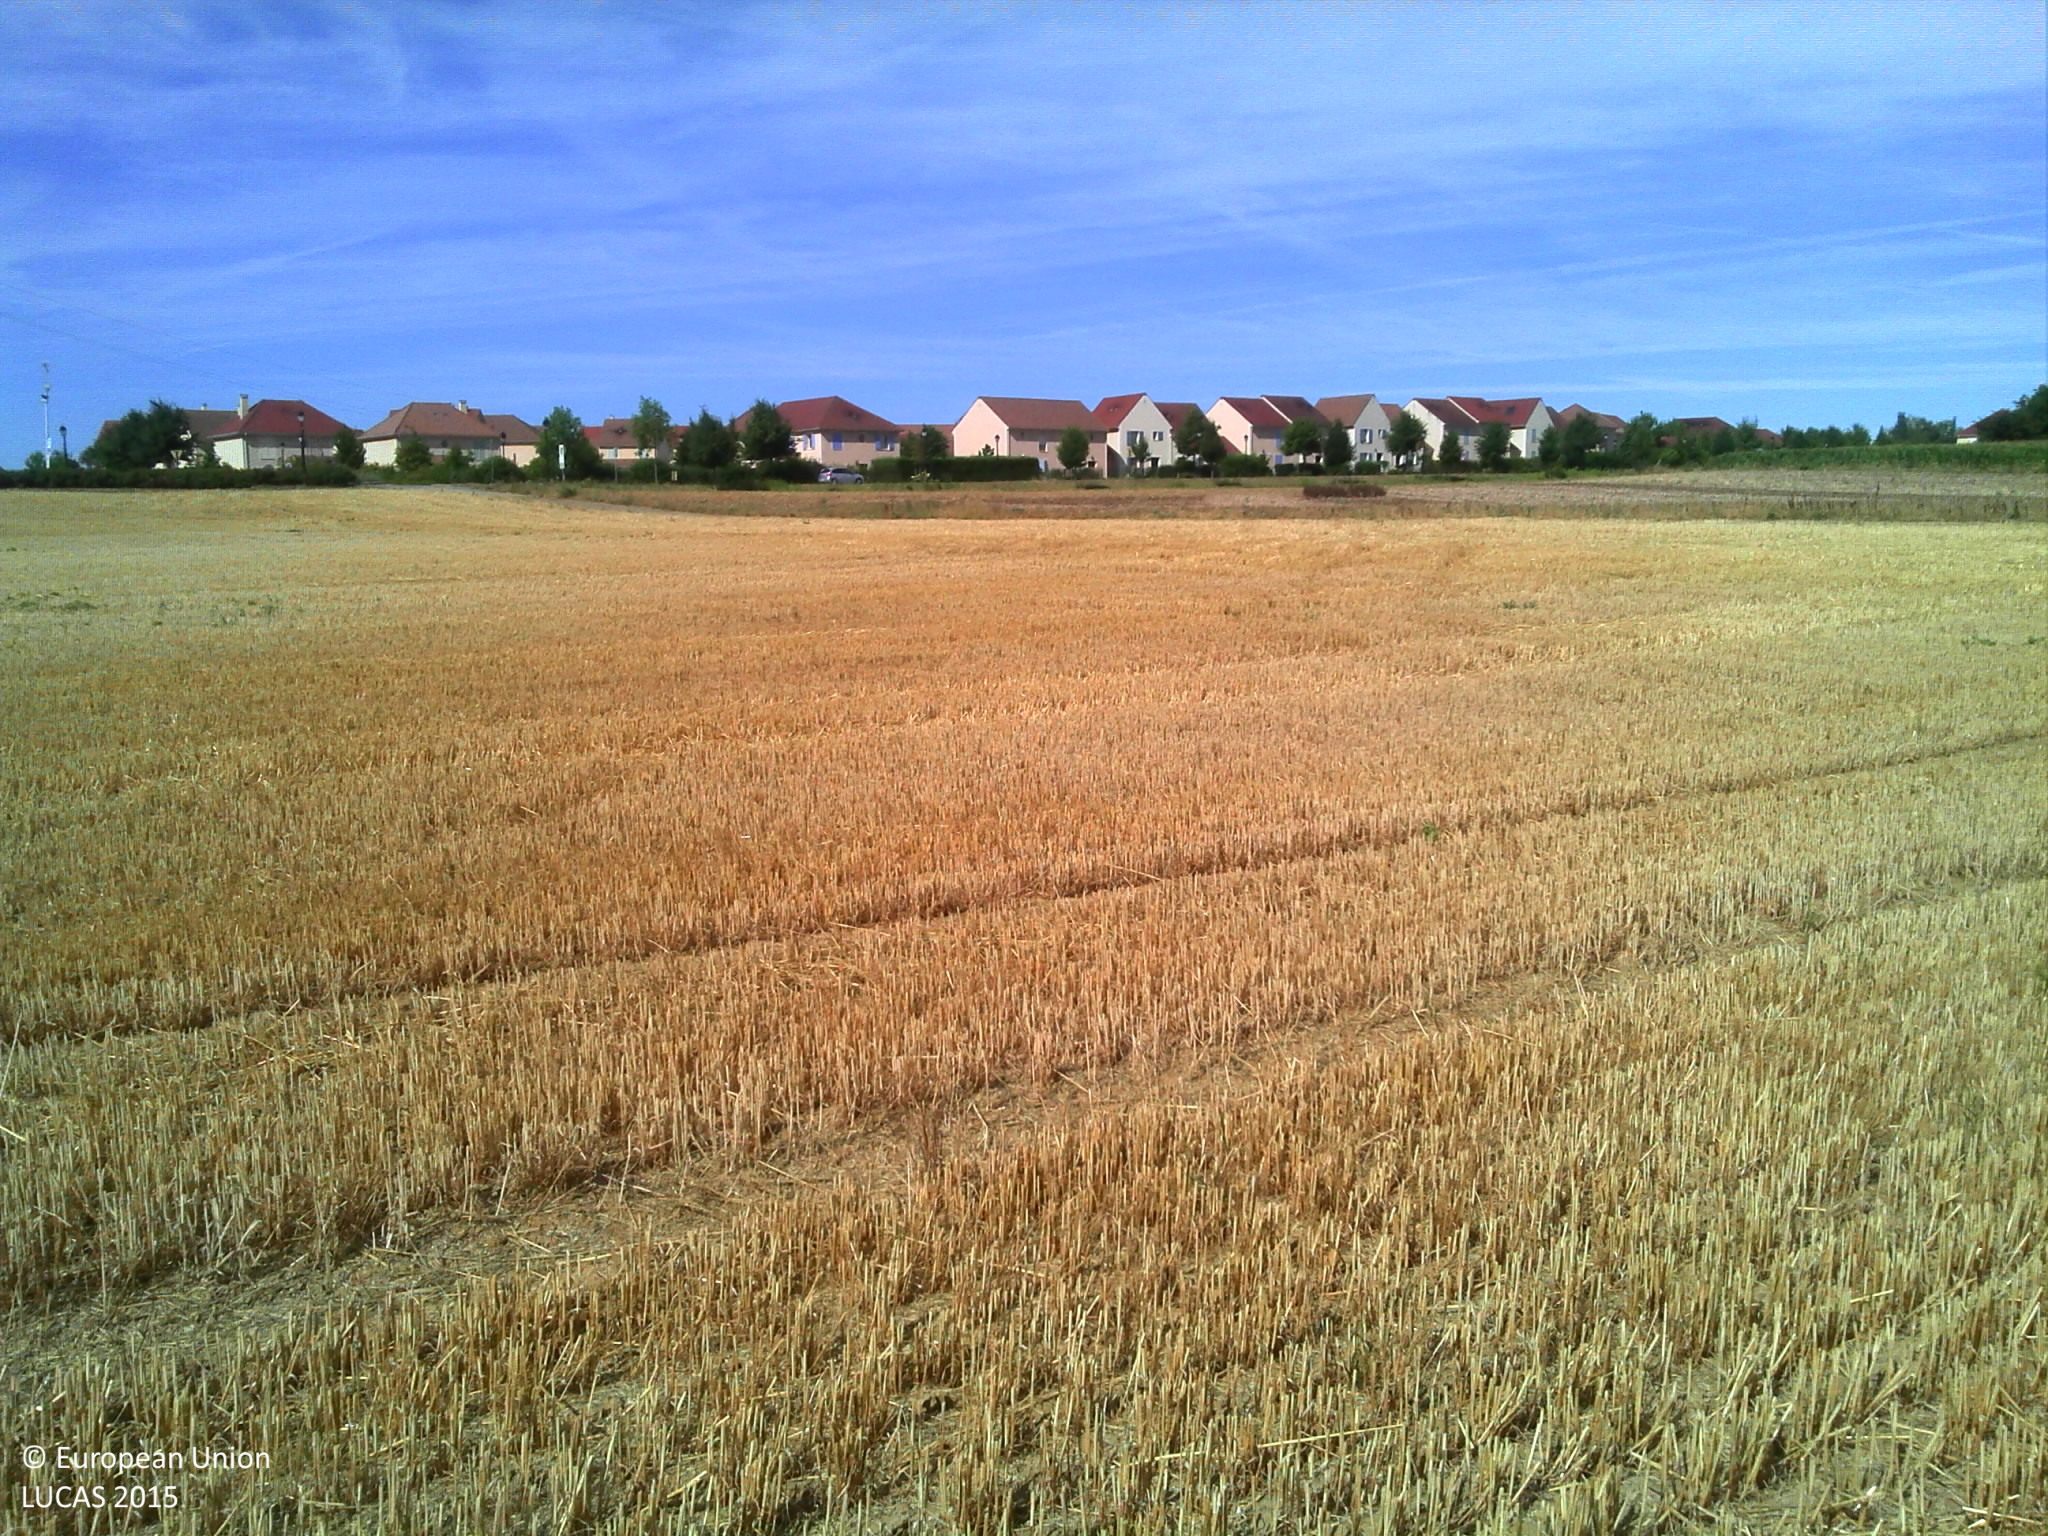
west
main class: Cropland
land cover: Common wheat
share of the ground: 10 - 25 %
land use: Agriculture (excluding fallow land and kitchen gardens)
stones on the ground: < 10 %
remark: Harvested field
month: August
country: FR
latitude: 49.0595
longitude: 2.6128
